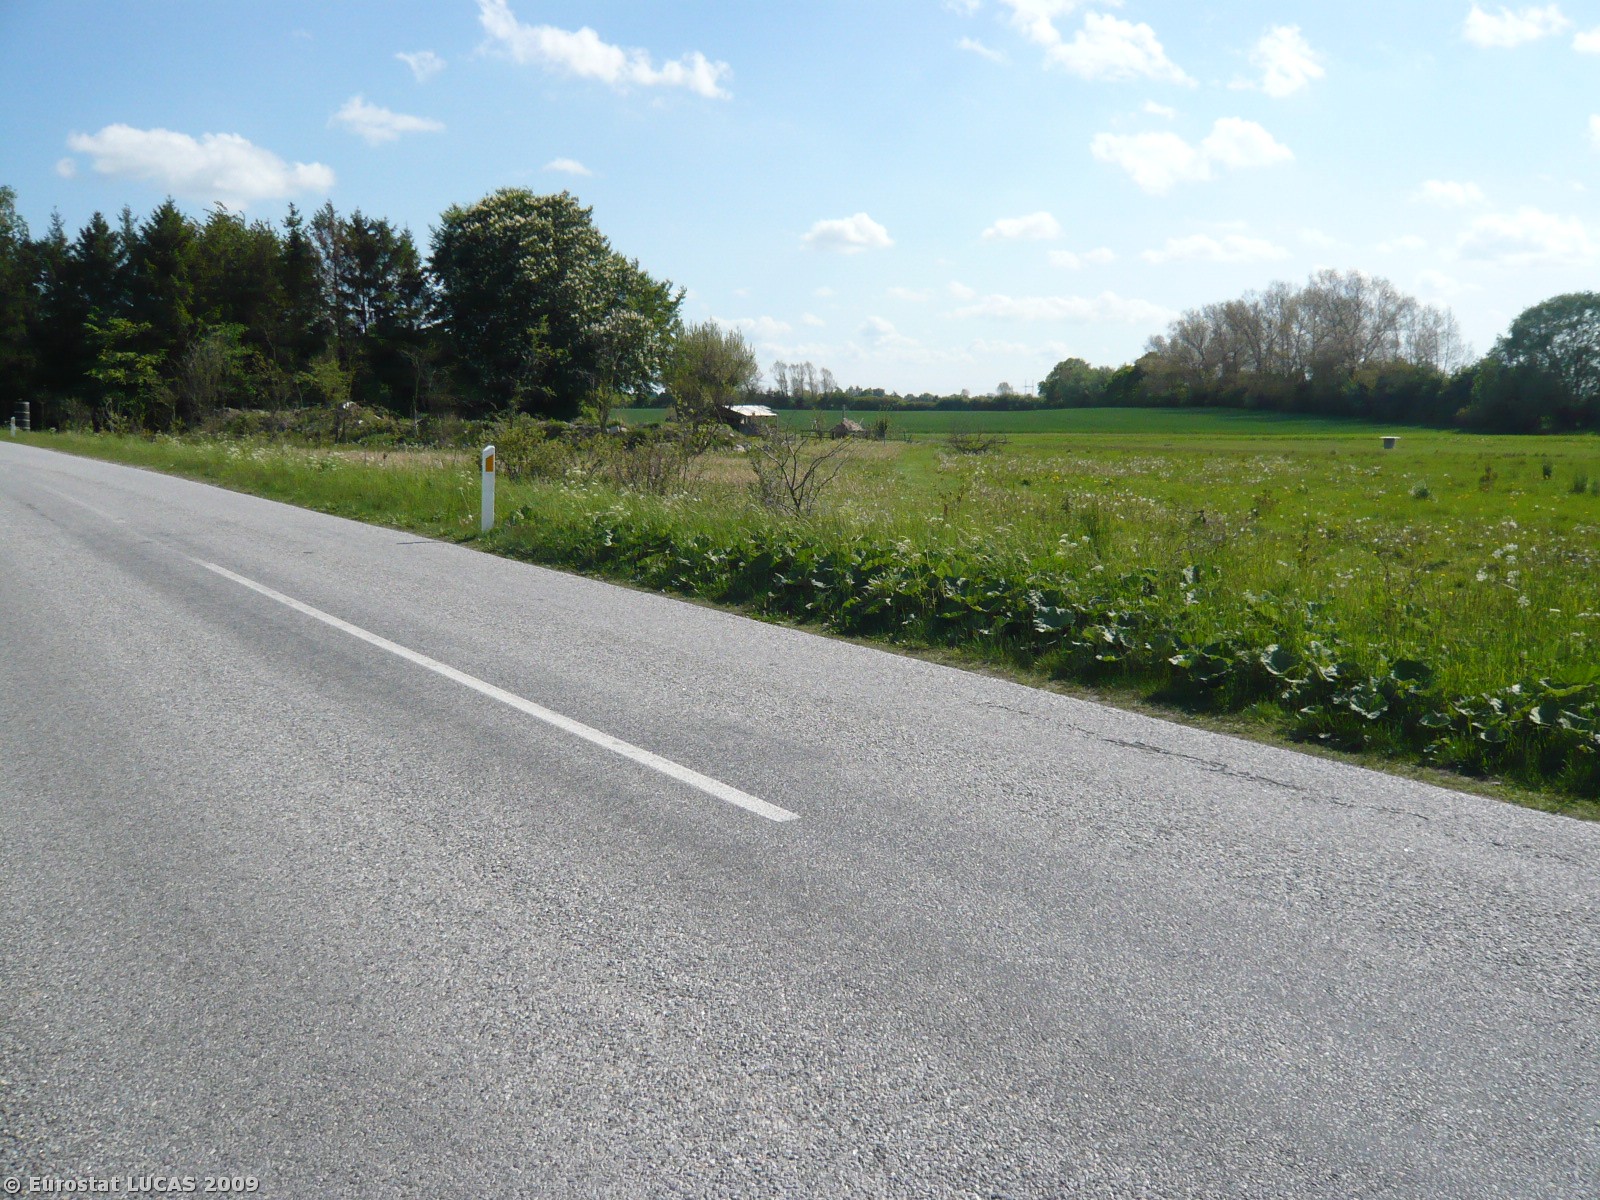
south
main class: Cropland
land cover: Common wheat
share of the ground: > 75 %
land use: Agriculture (excluding fallow land and kitchen gardens)
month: May
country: DK
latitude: 55.4143
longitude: 12.1624
